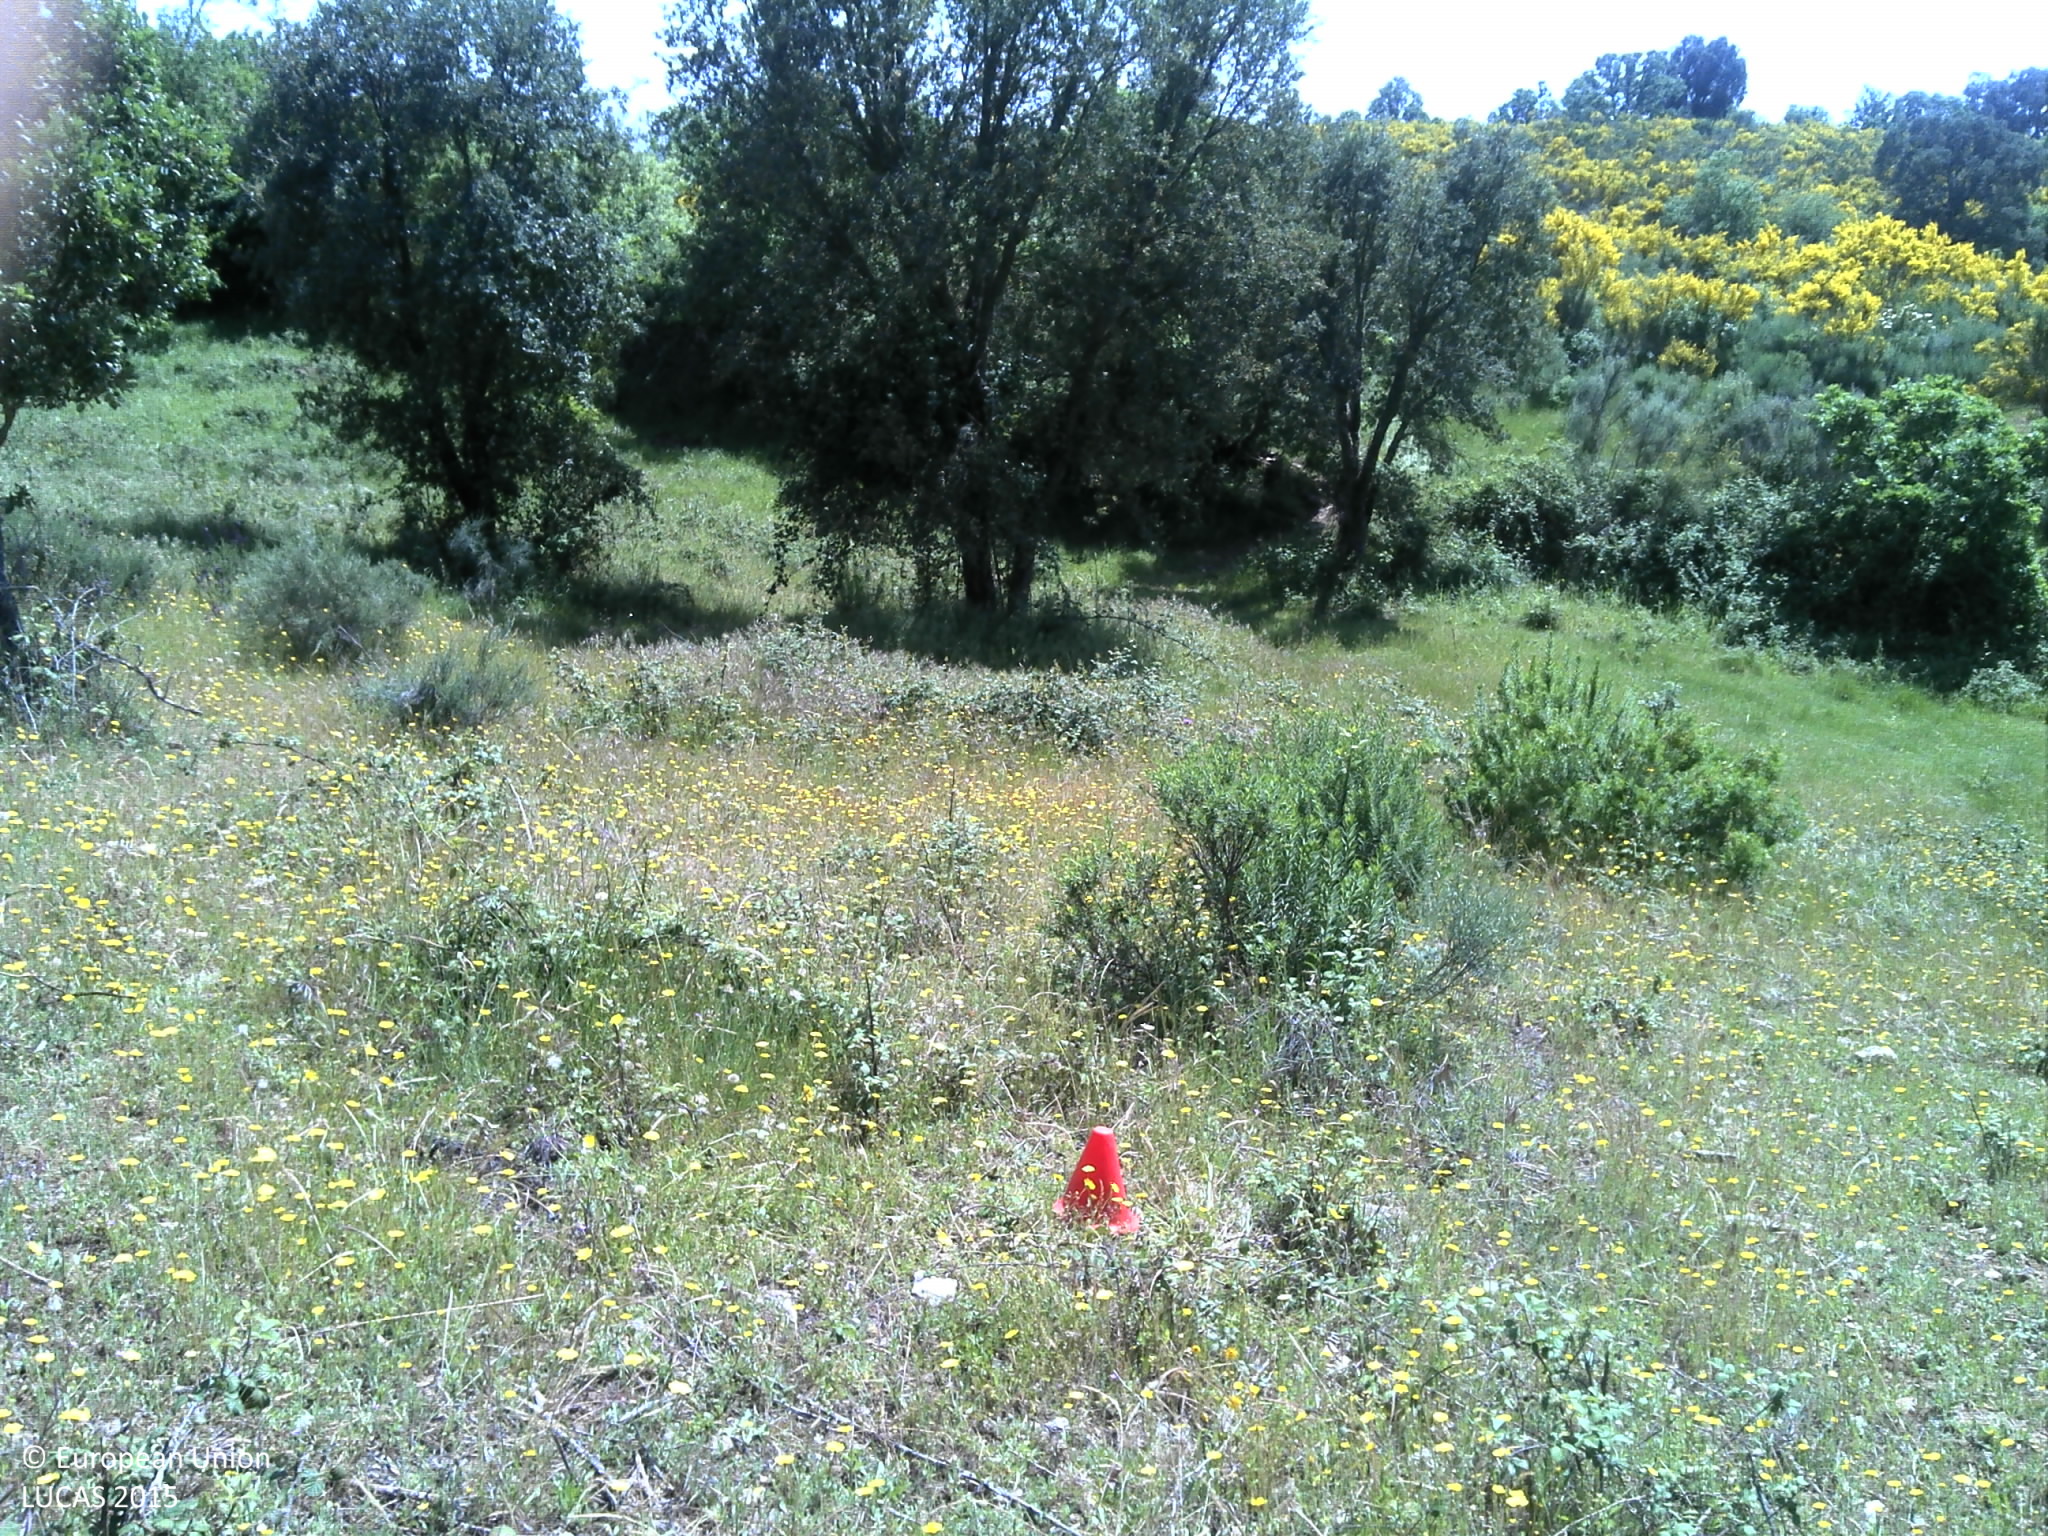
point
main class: Woodland
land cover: Broadleaved woodland
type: broadleaved evergreen forest
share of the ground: 25 - 50 %
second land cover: Spontaneously vegetated surfaces
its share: 50 - 75 %
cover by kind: herbaceous plants 50 %, broadleaved forest trees 40 %, consolidated bare surface 5 %, unconsolidated bare surface 5 %
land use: Forestry
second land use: Agriculture (excluding fallow land and kitchen gardens)
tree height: > 5 m
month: May
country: PT
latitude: 41.5881
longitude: -7.0183
